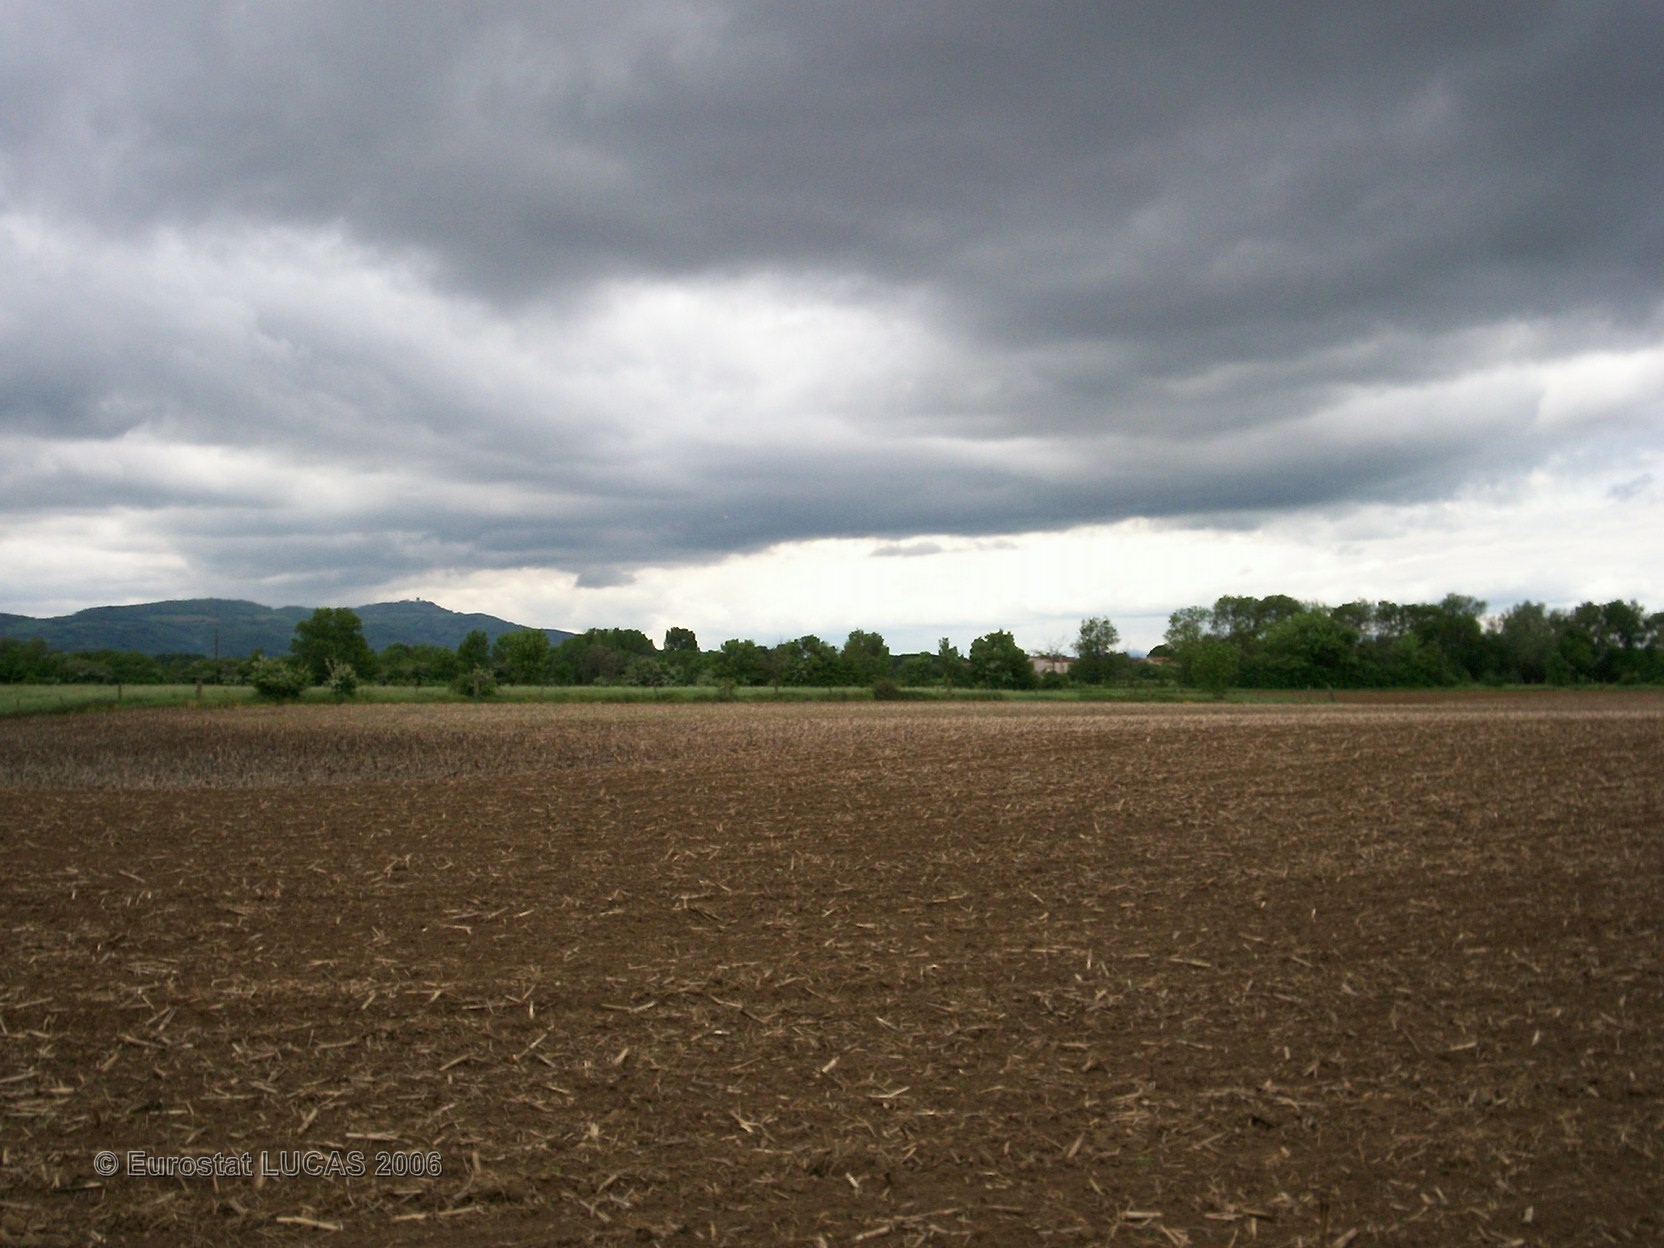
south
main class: Cropland
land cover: Maize
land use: Agriculture (excluding fallow land and kitchen gardens)
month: May
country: FR
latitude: 45.9350
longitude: 4.7797
